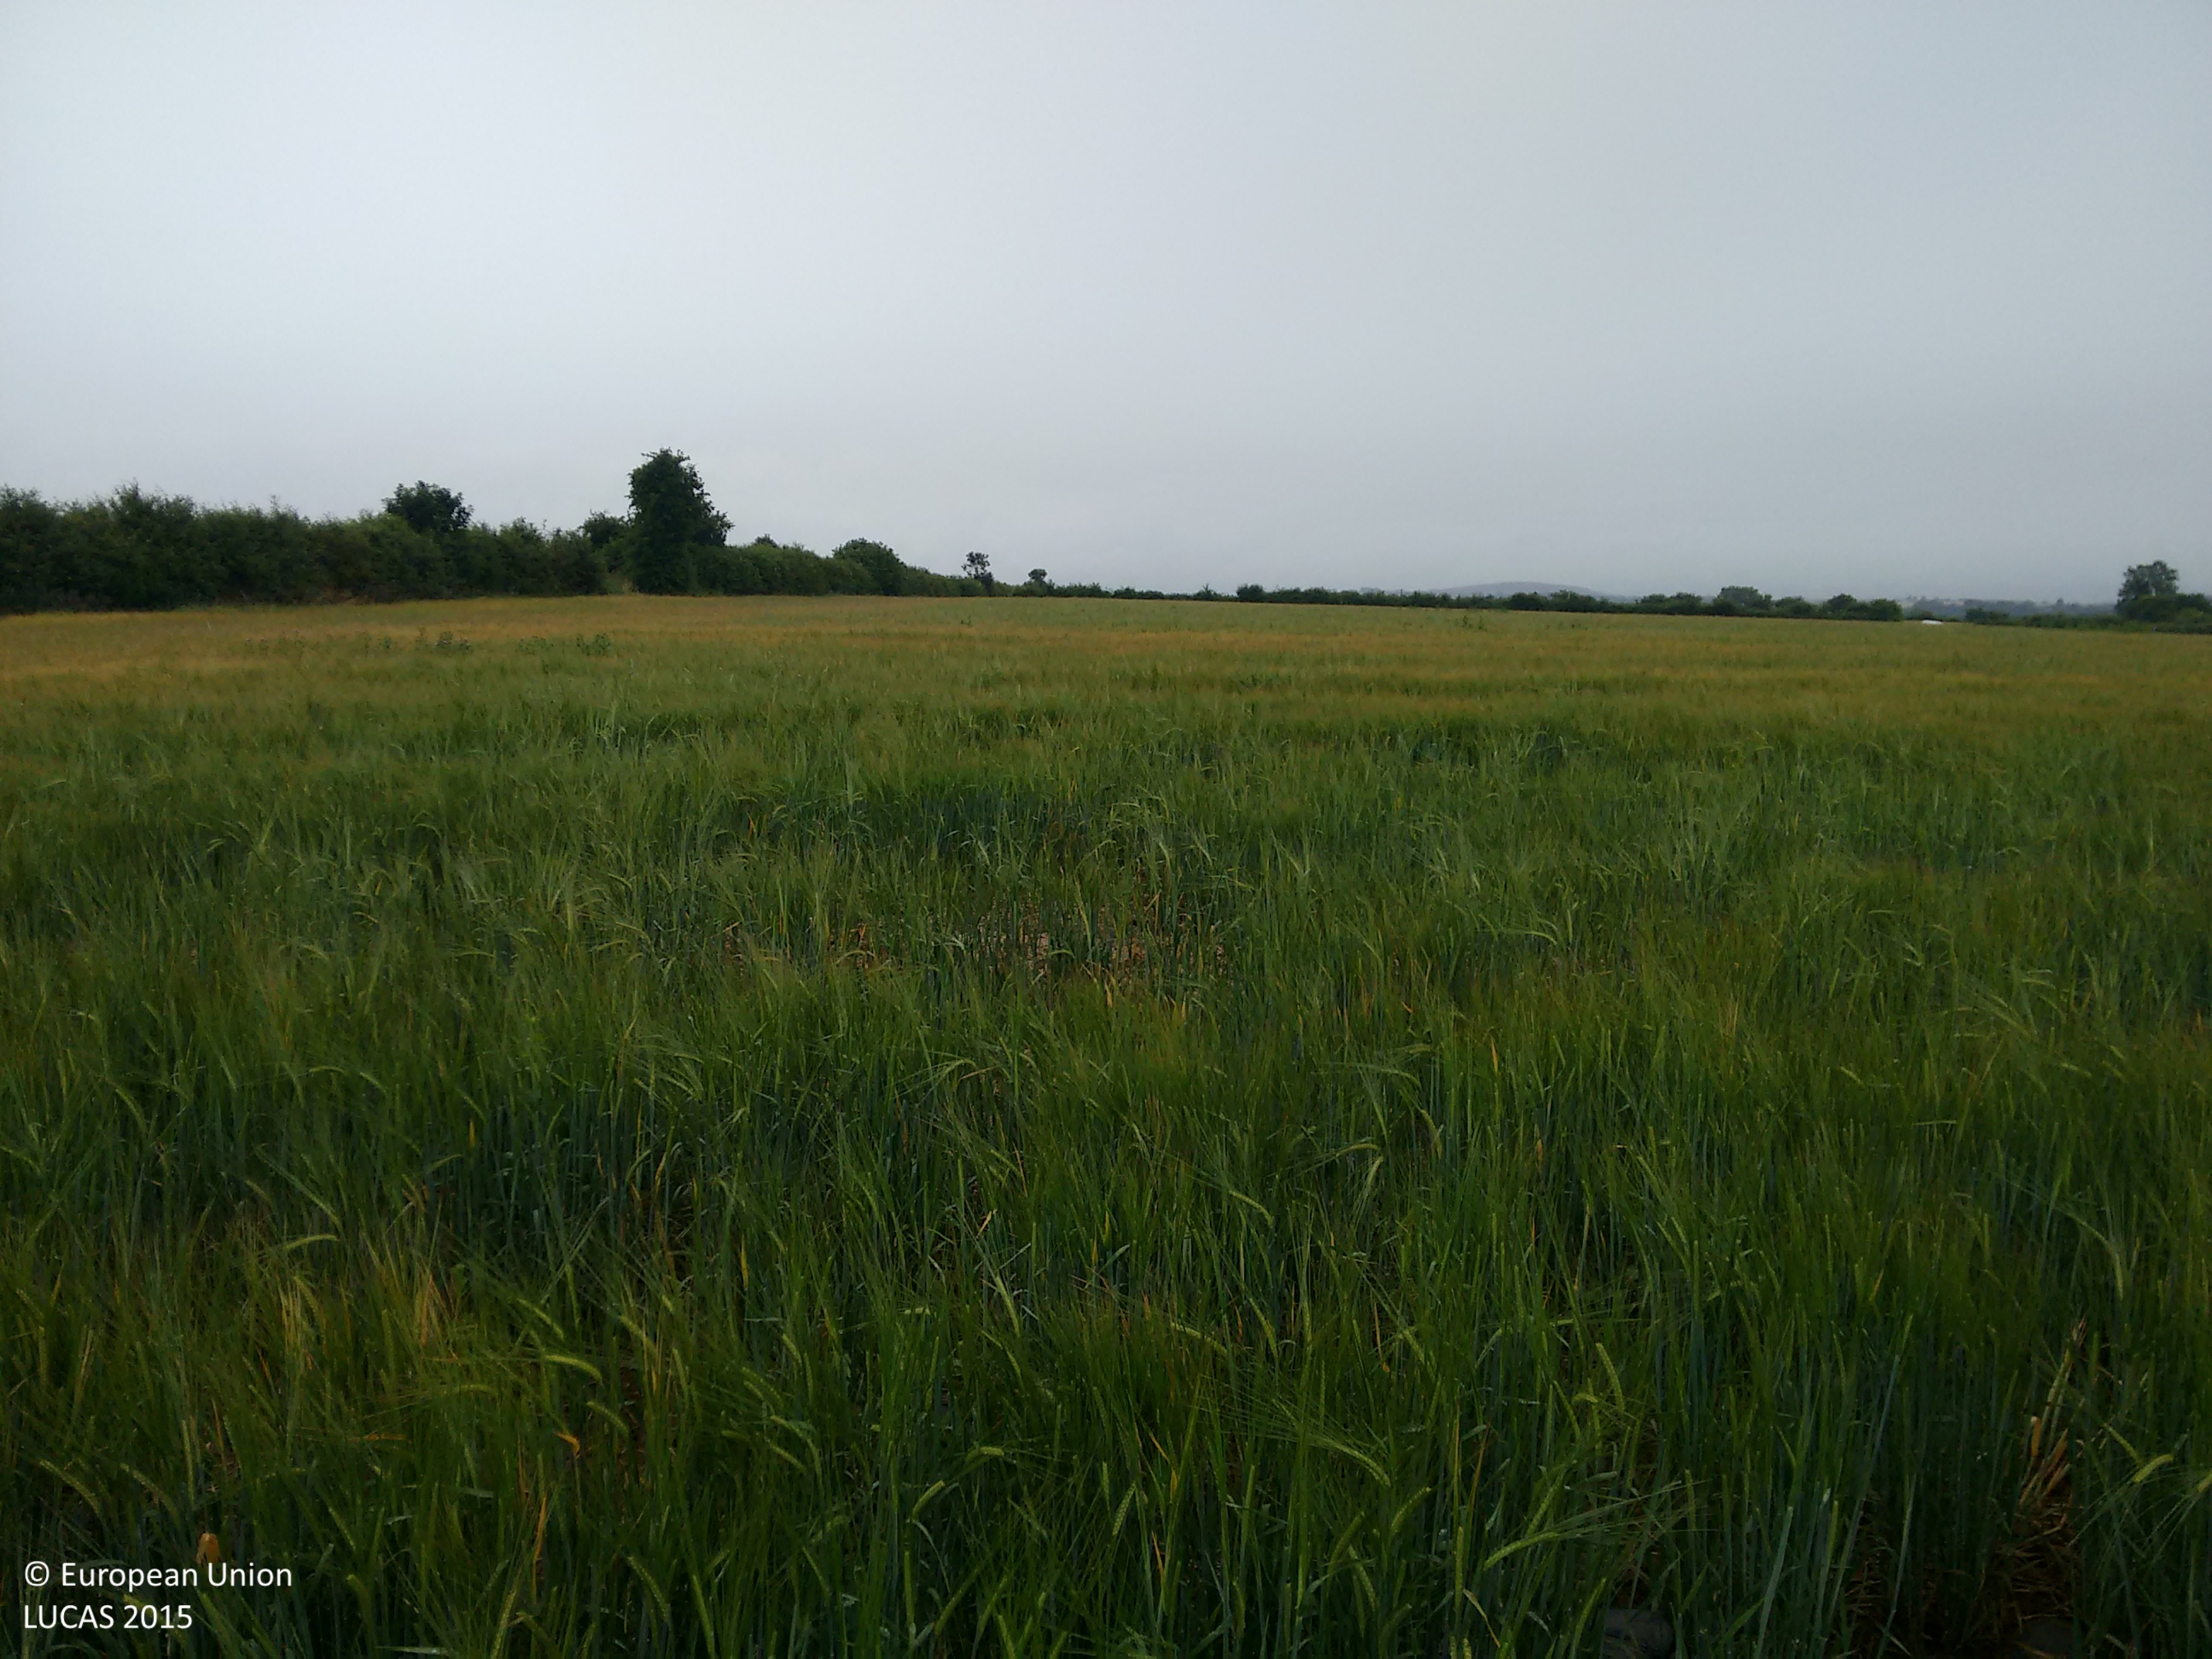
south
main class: Cropland
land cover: Barley
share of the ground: > 75 %
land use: Agriculture (excluding fallow land and kitchen gardens)
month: July
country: IE
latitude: 52.5599
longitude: -7.2165
